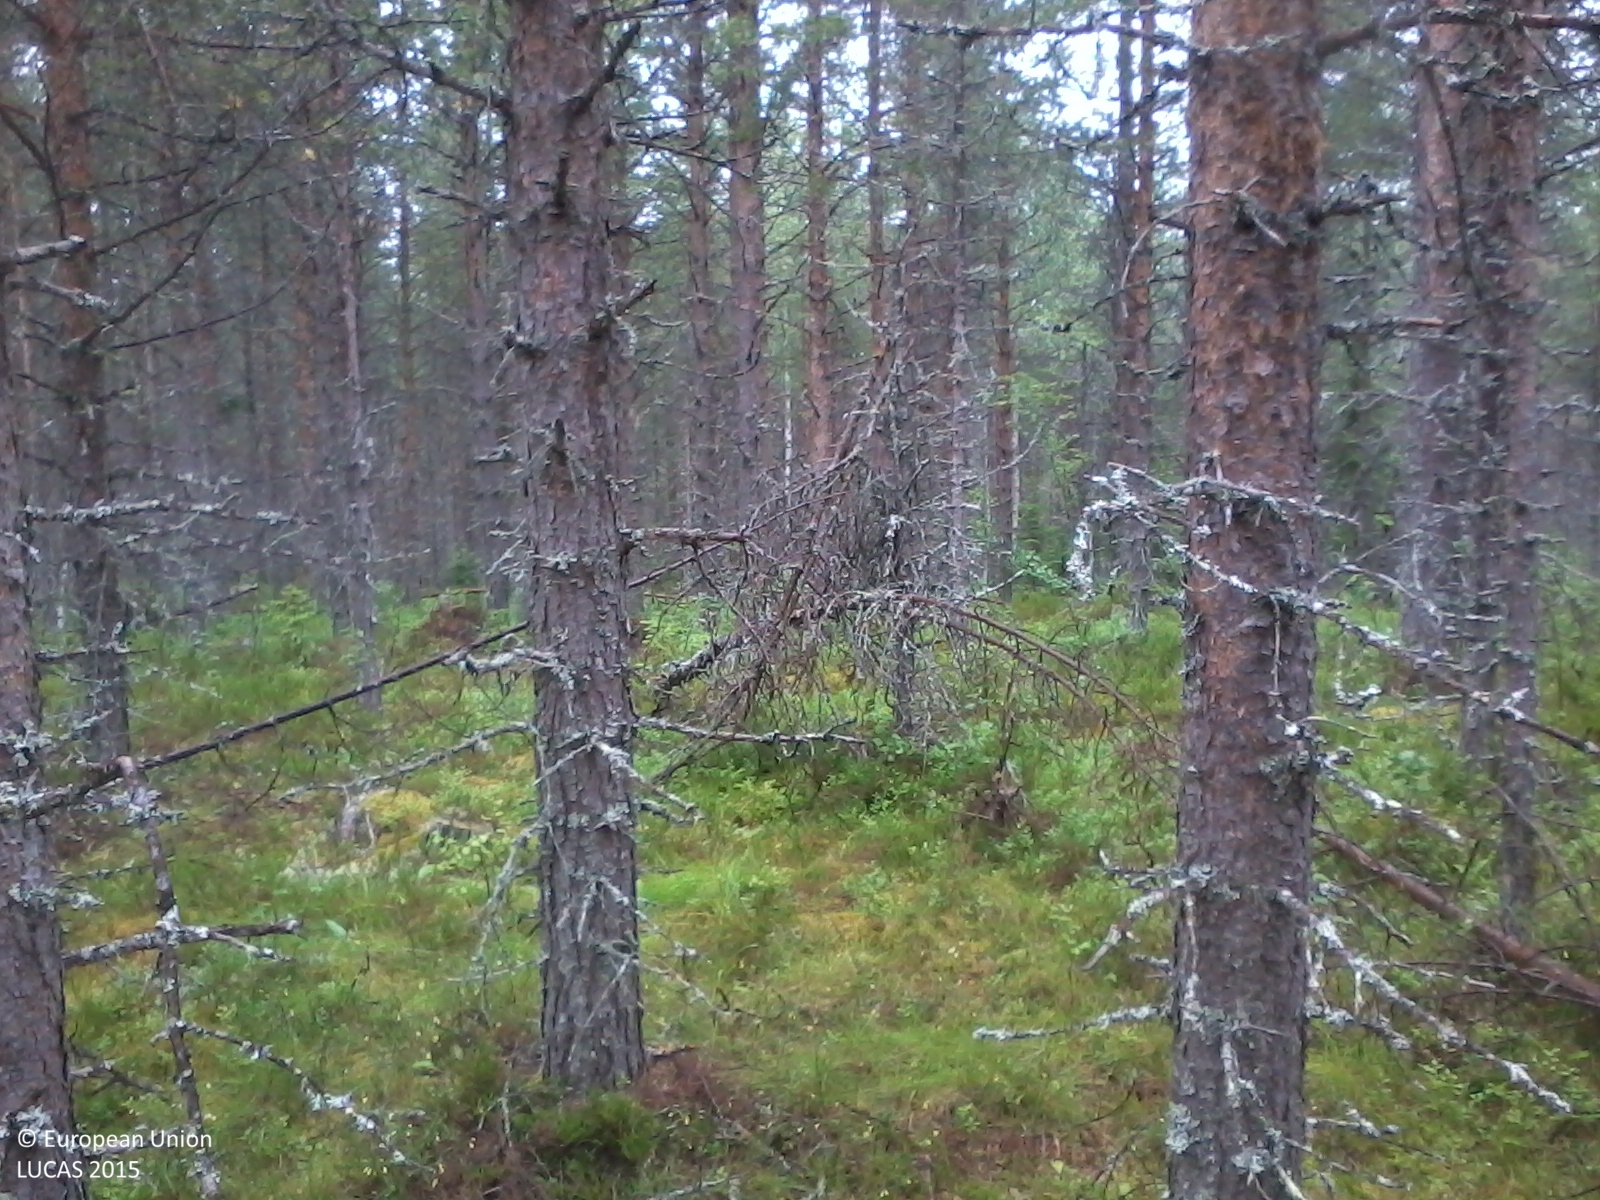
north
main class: Woodland
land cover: Pine dominated coniferous woodland
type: boreal forest
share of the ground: > 75 %
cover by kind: coniferous forest trees 75 %, lichens and mosses 15 %, shrubs 10 %
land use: Forestry
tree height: > 5 m
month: August
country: SE
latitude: 62.8879
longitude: 16.9201
